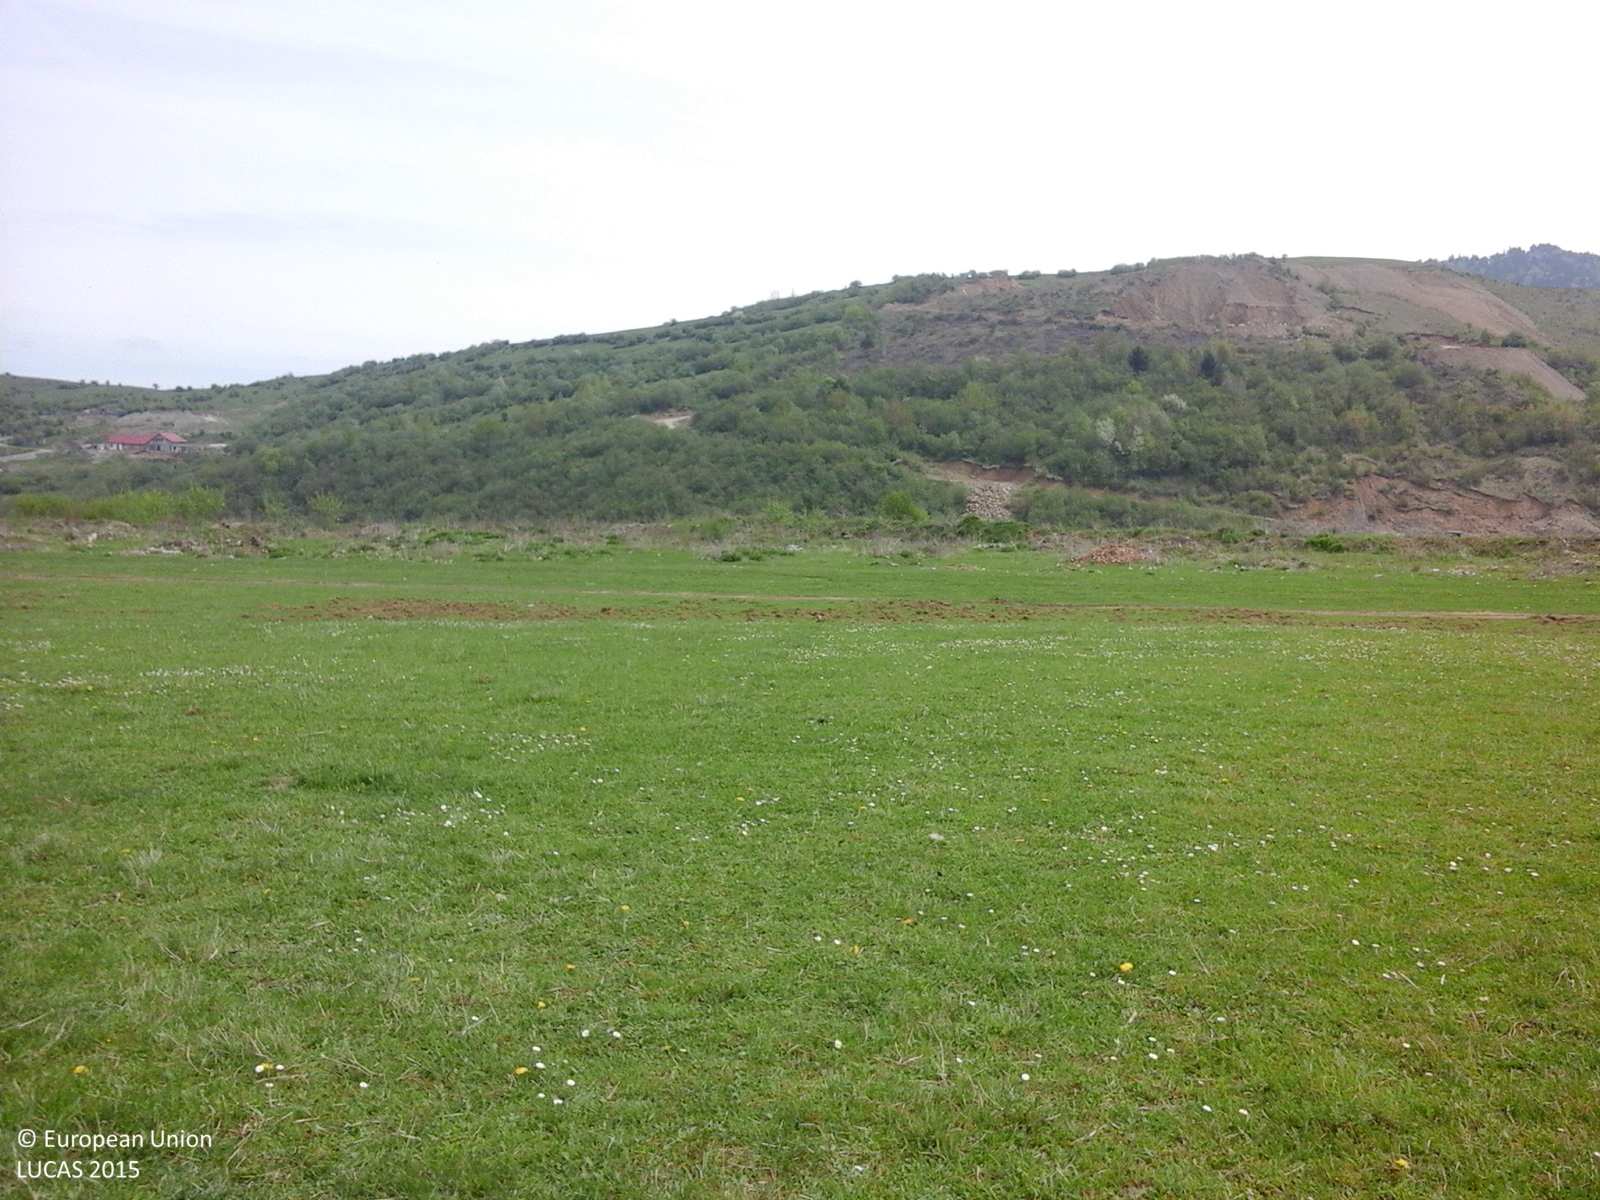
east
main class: Grassland
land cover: Grassland without tree/shrub cover
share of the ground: > 75 %
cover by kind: herbaceous plants 100 %
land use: Agriculture (excluding fallow land and kitchen gardens)
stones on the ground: < 10 %
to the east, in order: Grassland without tree/shrub cover; Tracks; Grassland without tree/shrub cover; Rocks and stones; Ditches and canals; Grass margins; Paved roads, cycling and walking lanes; Grassland with sparse tree/shrub cover; Grassland without tree/shrub cover; Shrubland with sparse tree cover; Inland fresh running water; Shrubland with sparse tree cover
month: May
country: RO
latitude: 45.6167
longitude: 25.7402
